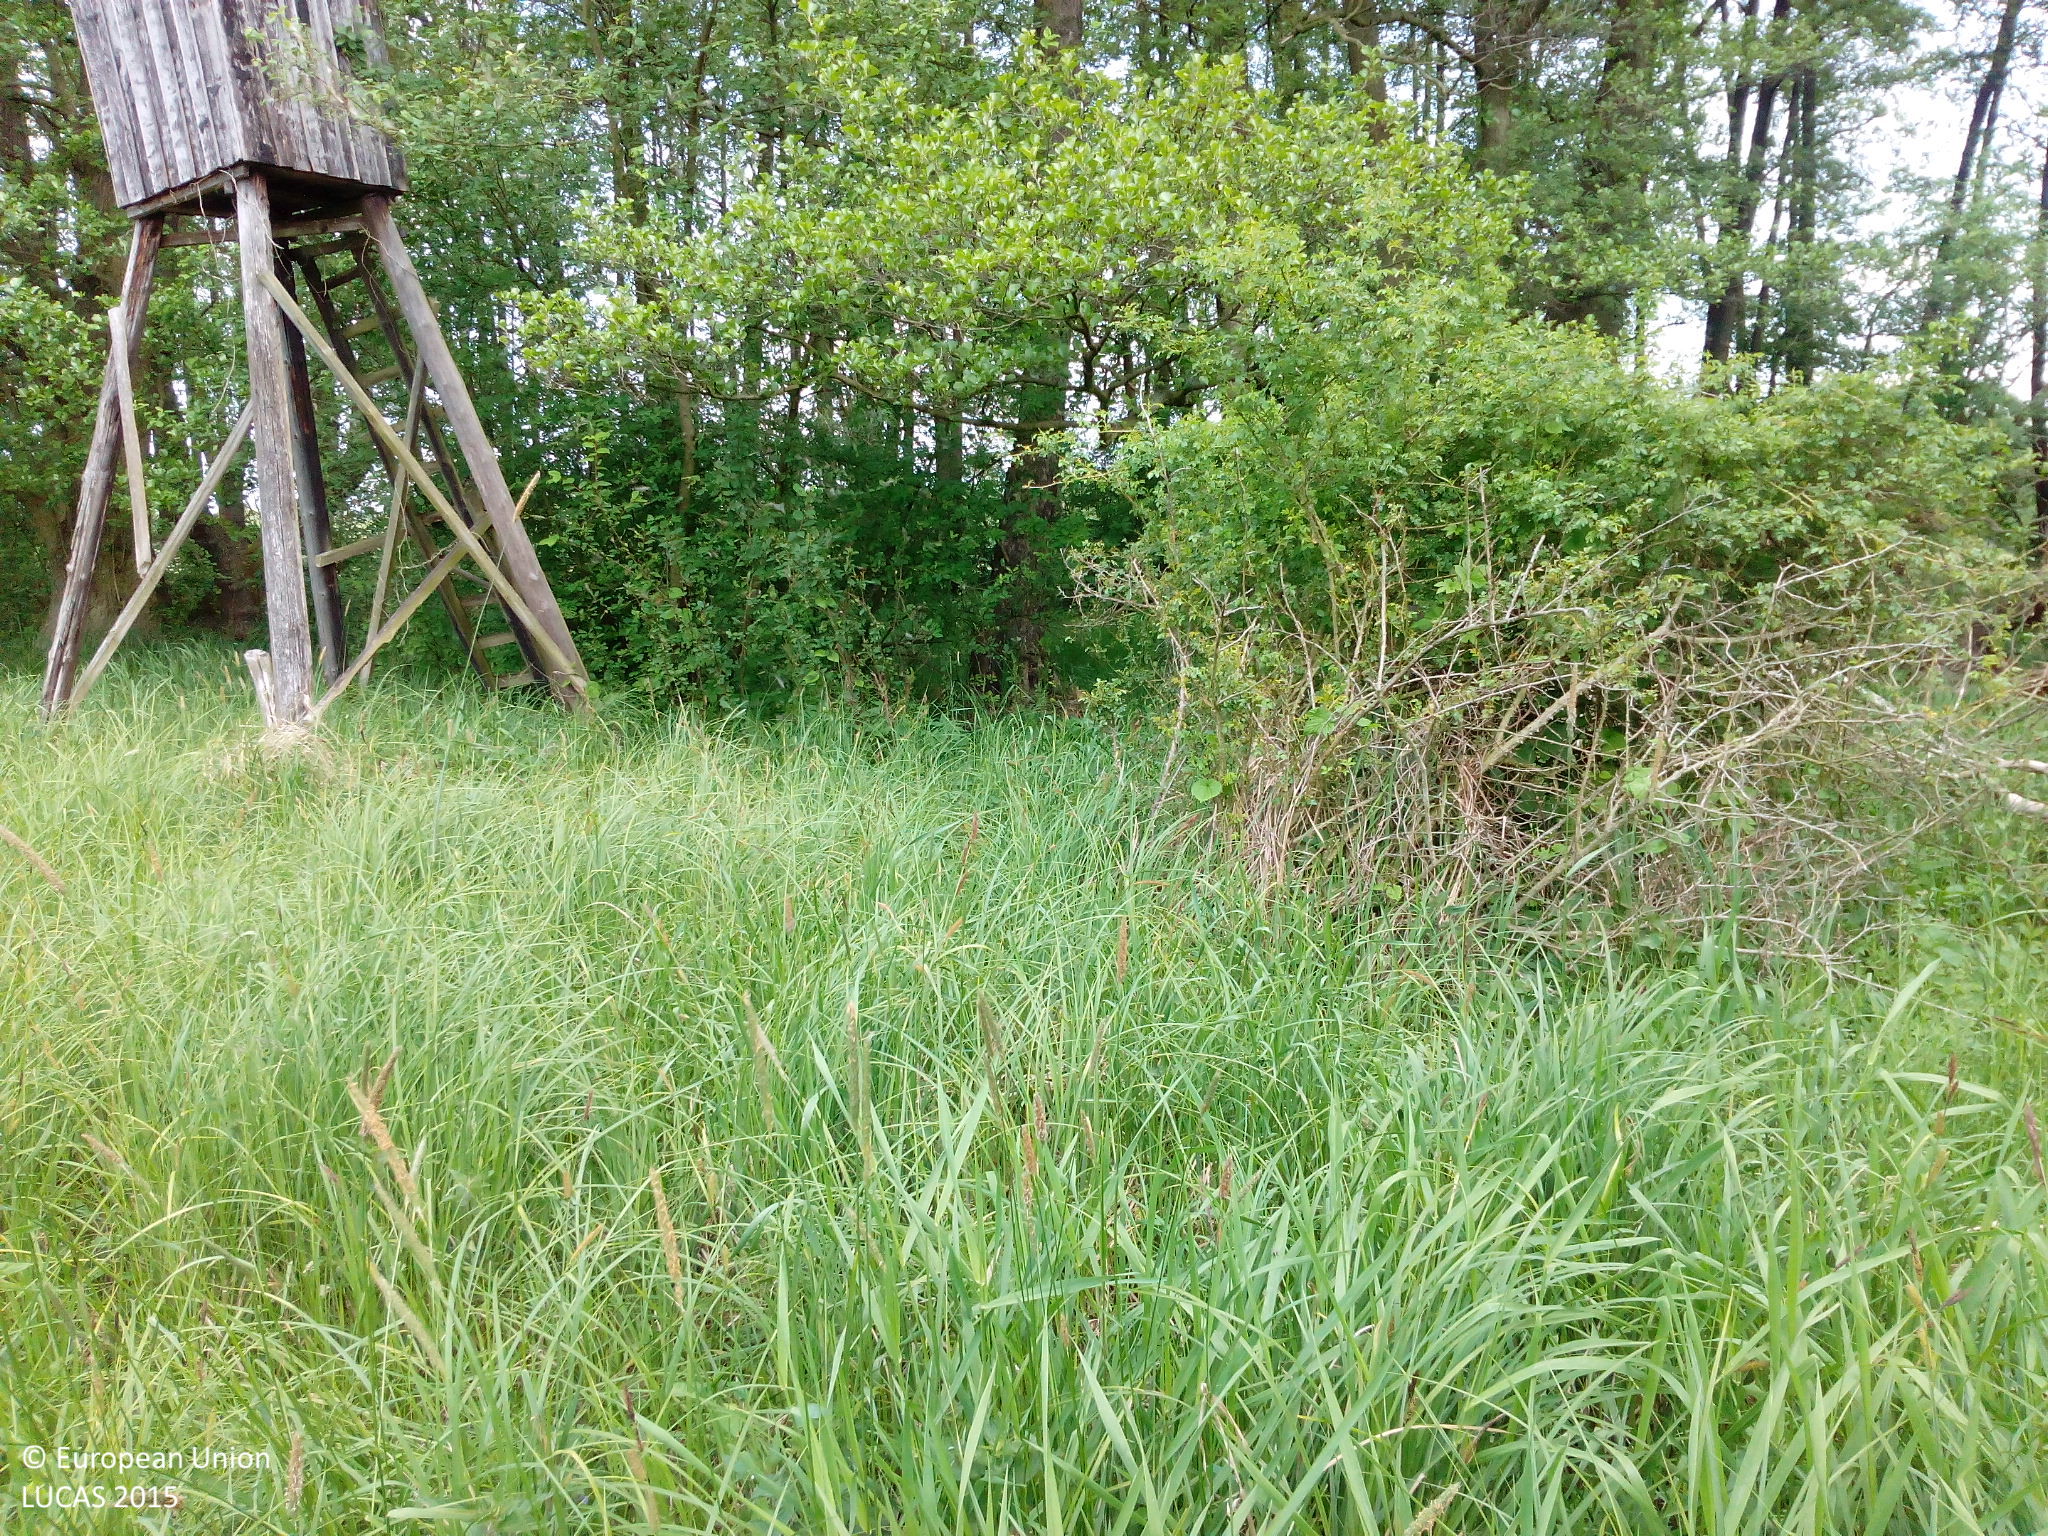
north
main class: Grassland
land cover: Grassland without tree/shrub cover
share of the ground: > 75 %
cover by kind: herbaceous plants 100 %
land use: Agriculture (excluding fallow land and kitchen gardens)
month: May
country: DE
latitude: 51.8405
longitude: 14.0505
